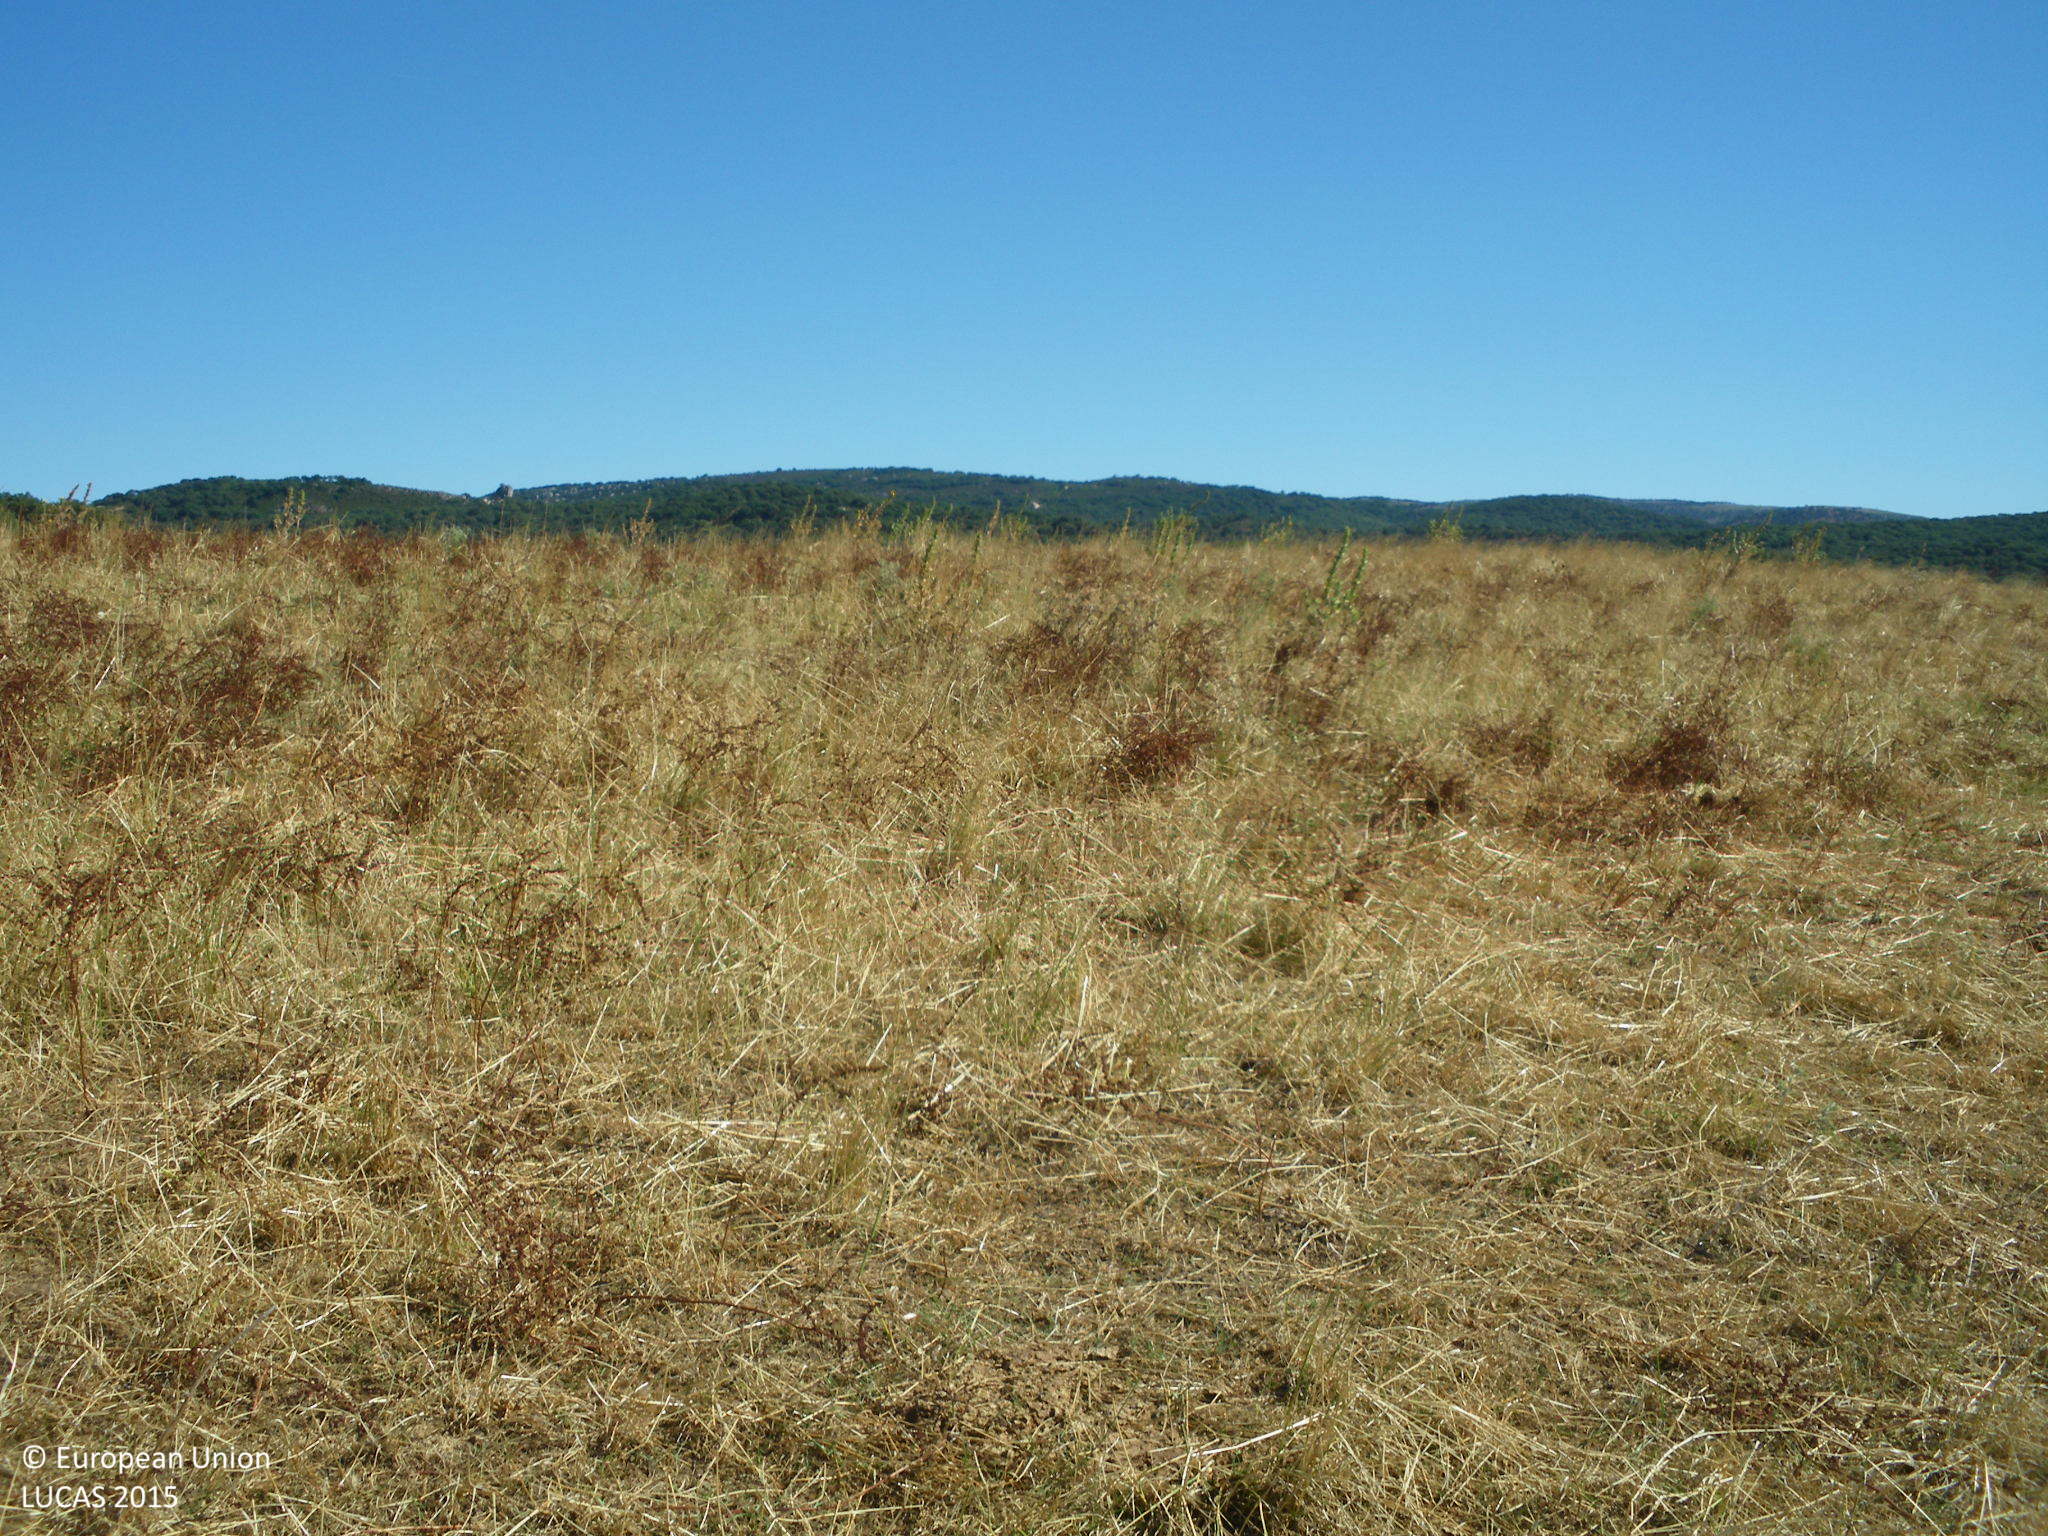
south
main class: Grassland
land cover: Spontaneously vegetated surfaces
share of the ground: > 75 %
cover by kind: herbaceous plants 100 %
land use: Fallow land
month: June
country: ES
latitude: 36.2281
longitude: -5.8300
